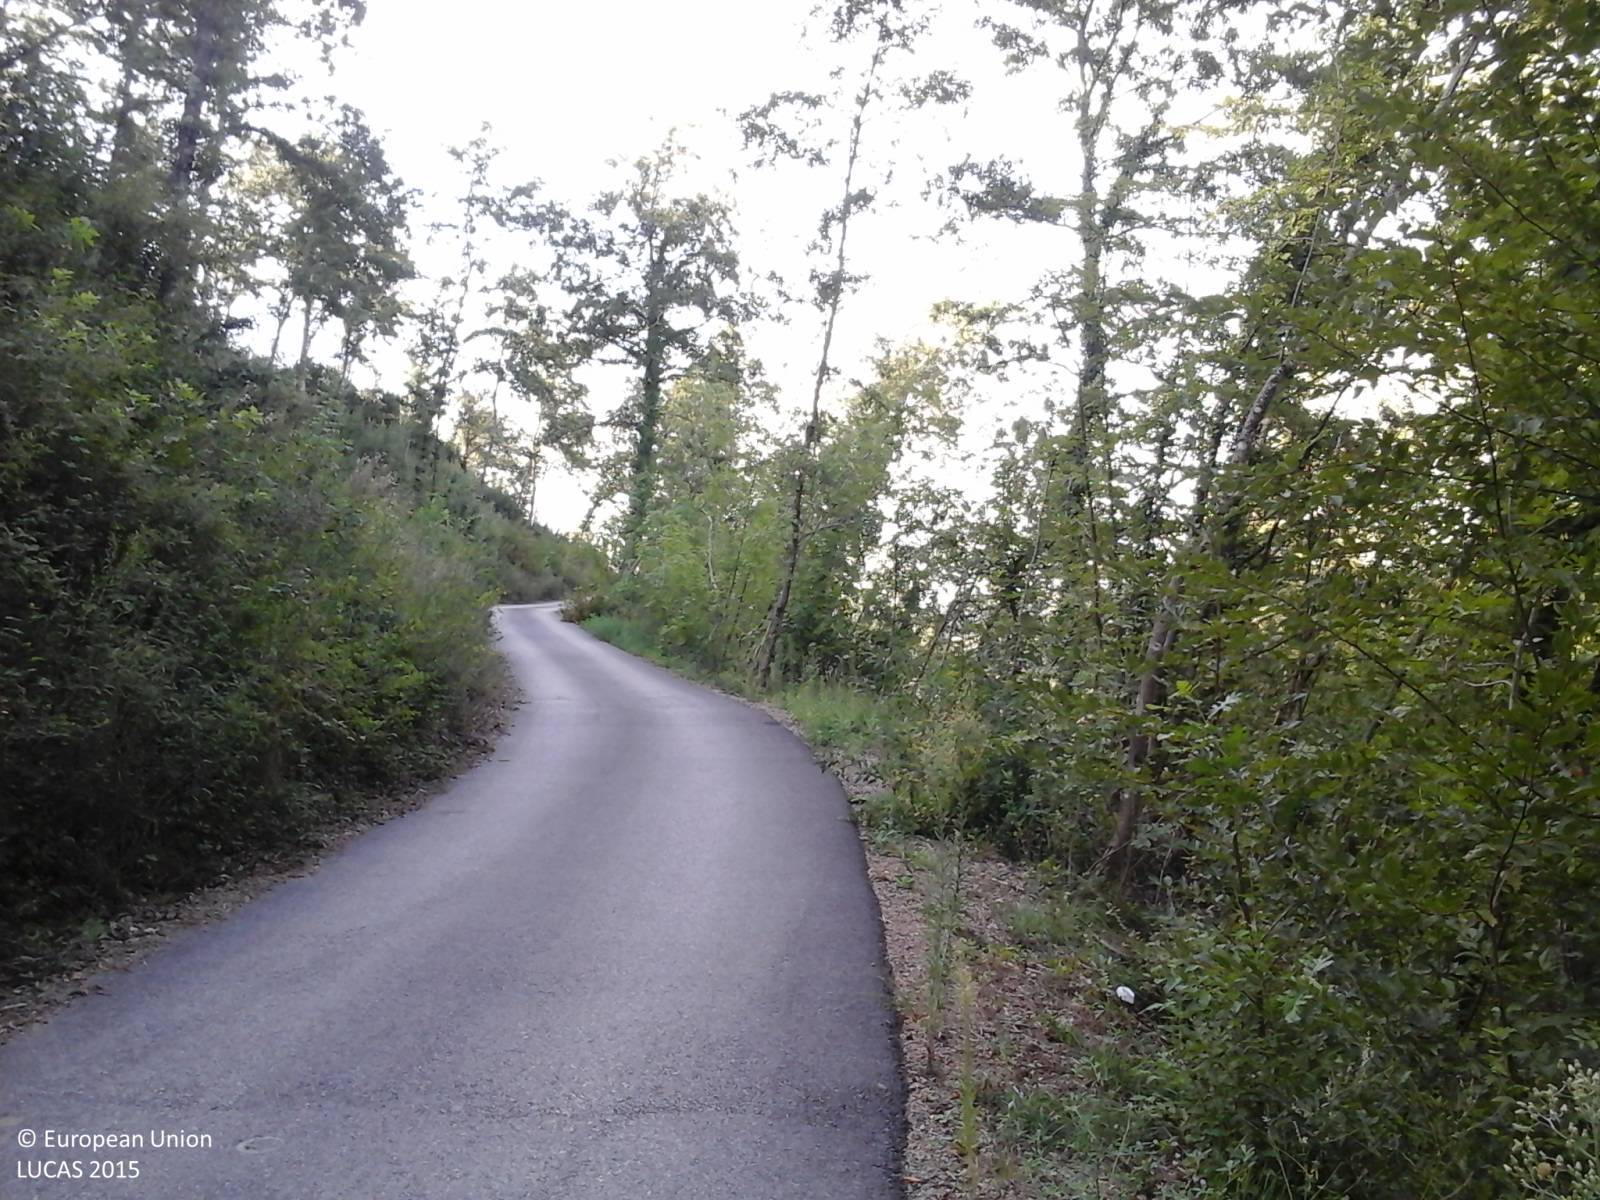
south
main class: Woodland
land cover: Broadleaved woodland
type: mesophytic deciduous forest
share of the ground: > 75 %
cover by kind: broadleaved forest trees 85 %, shrubs 15 %
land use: Forestry
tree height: > 5 m
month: September
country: IT
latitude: 43.1502
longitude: 12.3665
